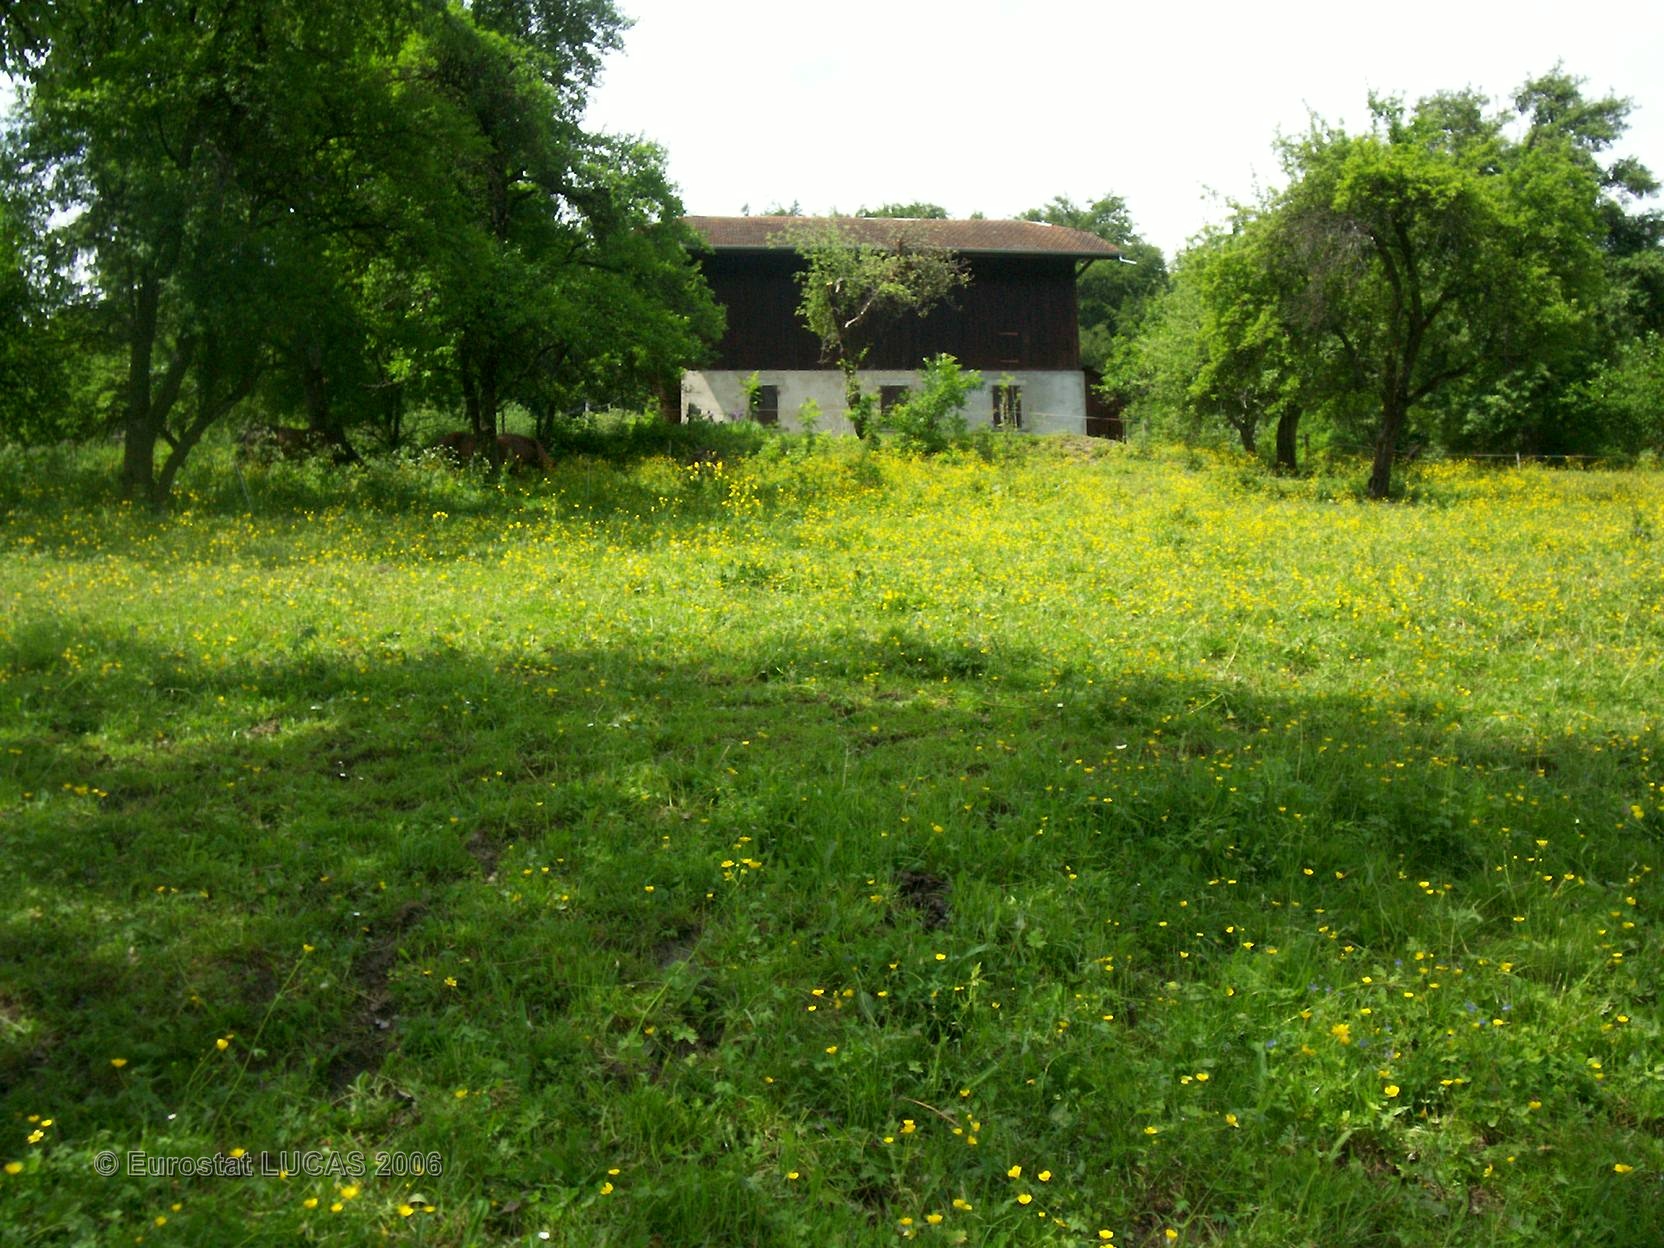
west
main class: Grassland
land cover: Grassland with sparse tree/shrub cover
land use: Agriculture (excluding fallow land and kitchen gardens)
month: May
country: FR
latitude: 45.9198
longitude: 6.6386
